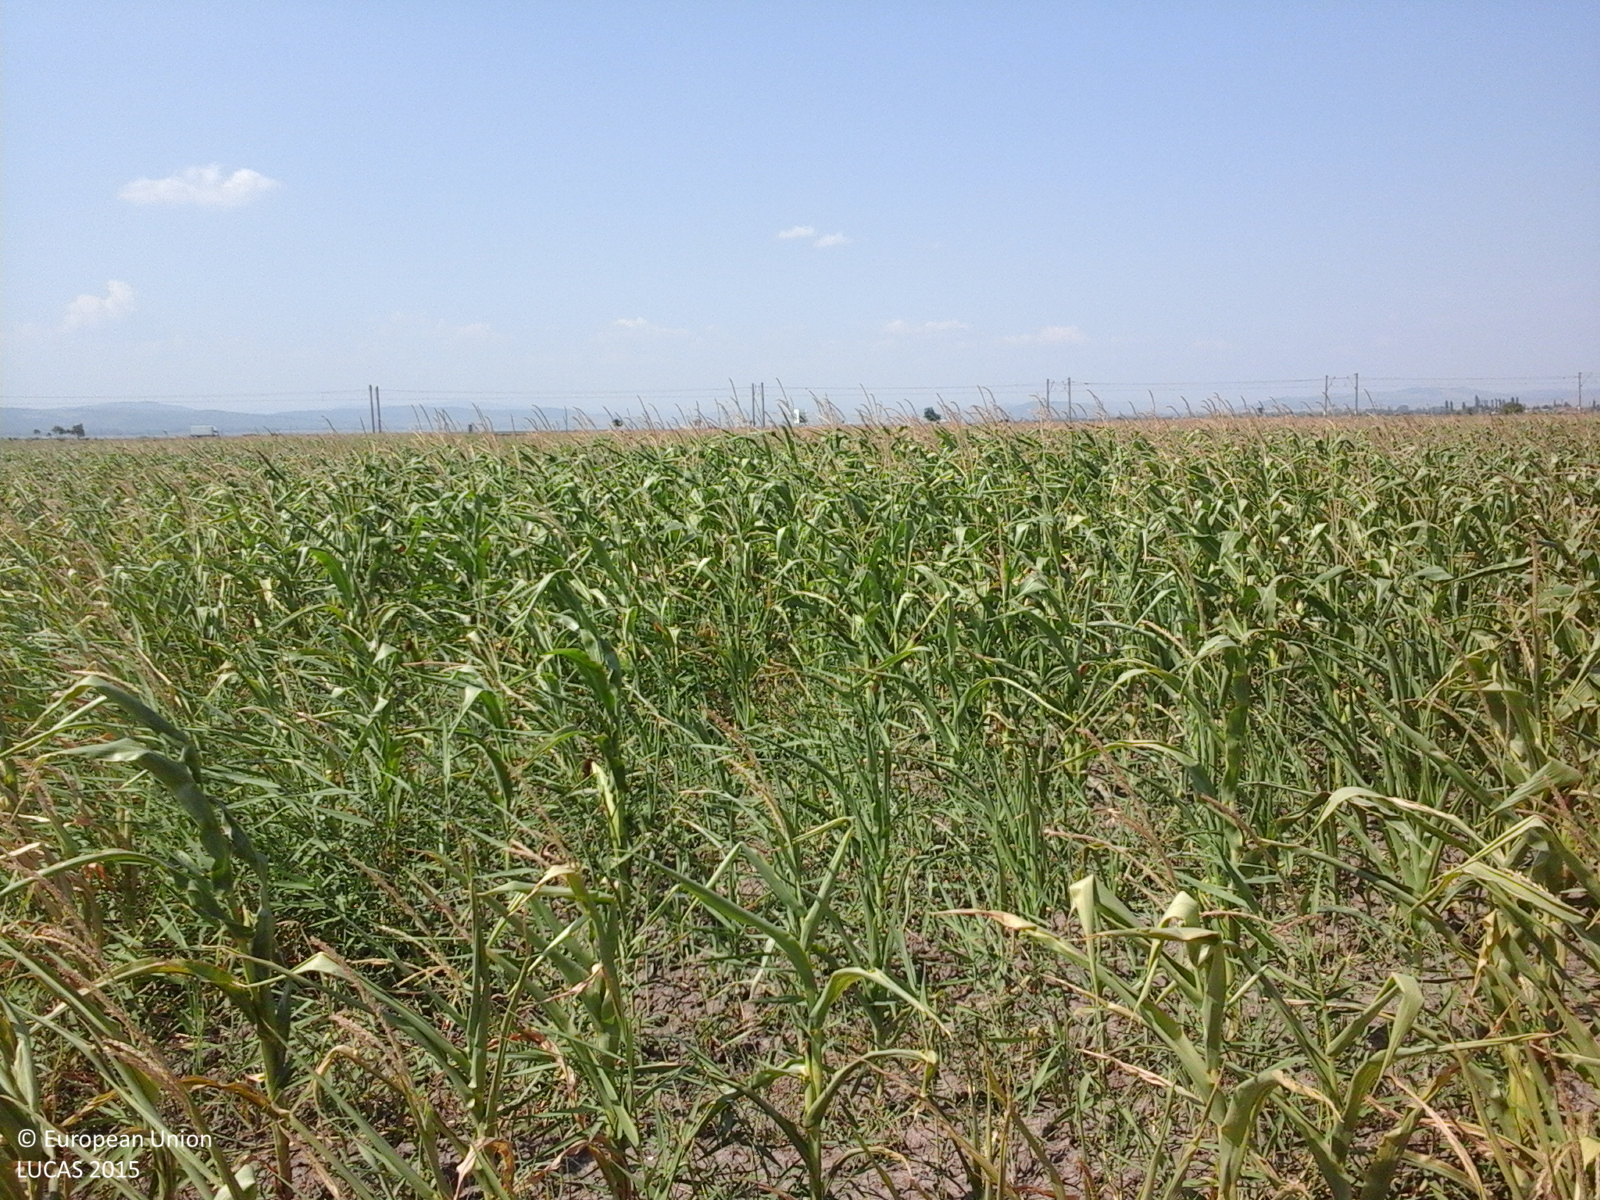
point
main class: Cropland
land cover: Maize
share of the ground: > 75 %
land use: Agriculture (excluding fallow land and kitchen gardens)
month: August
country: RO
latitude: 45.1251
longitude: 26.7712
